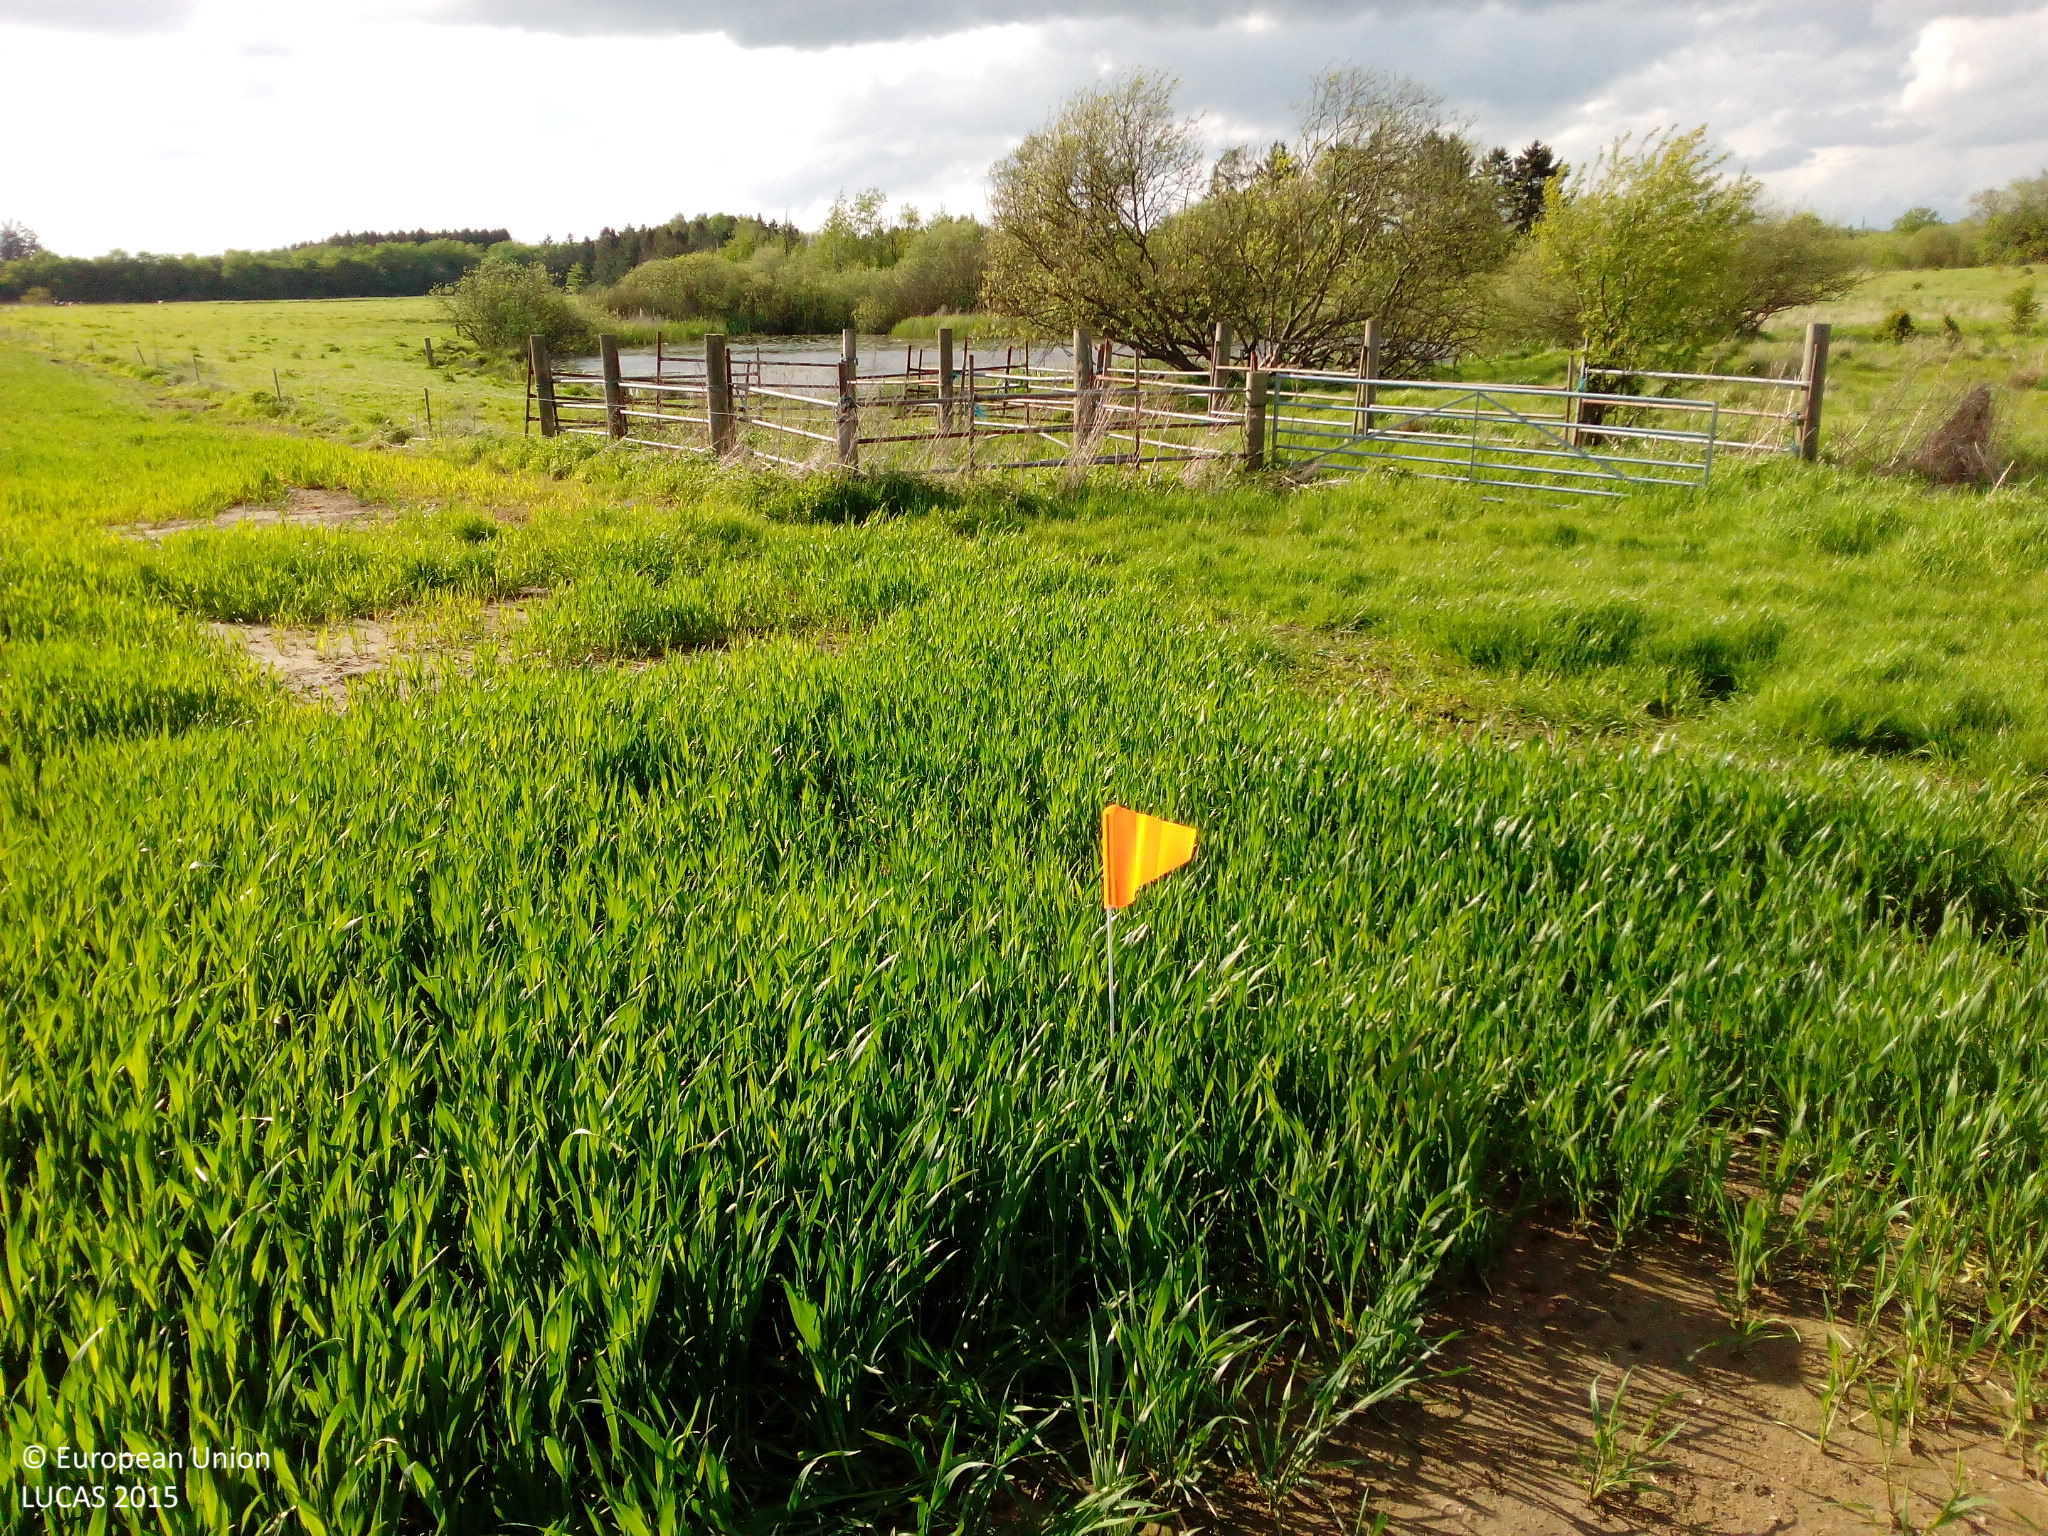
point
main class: Cropland
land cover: Common wheat
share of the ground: > 75 %
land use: Agriculture (excluding fallow land and kitchen gardens)
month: May
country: DK
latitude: 55.5781
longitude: 12.0445
